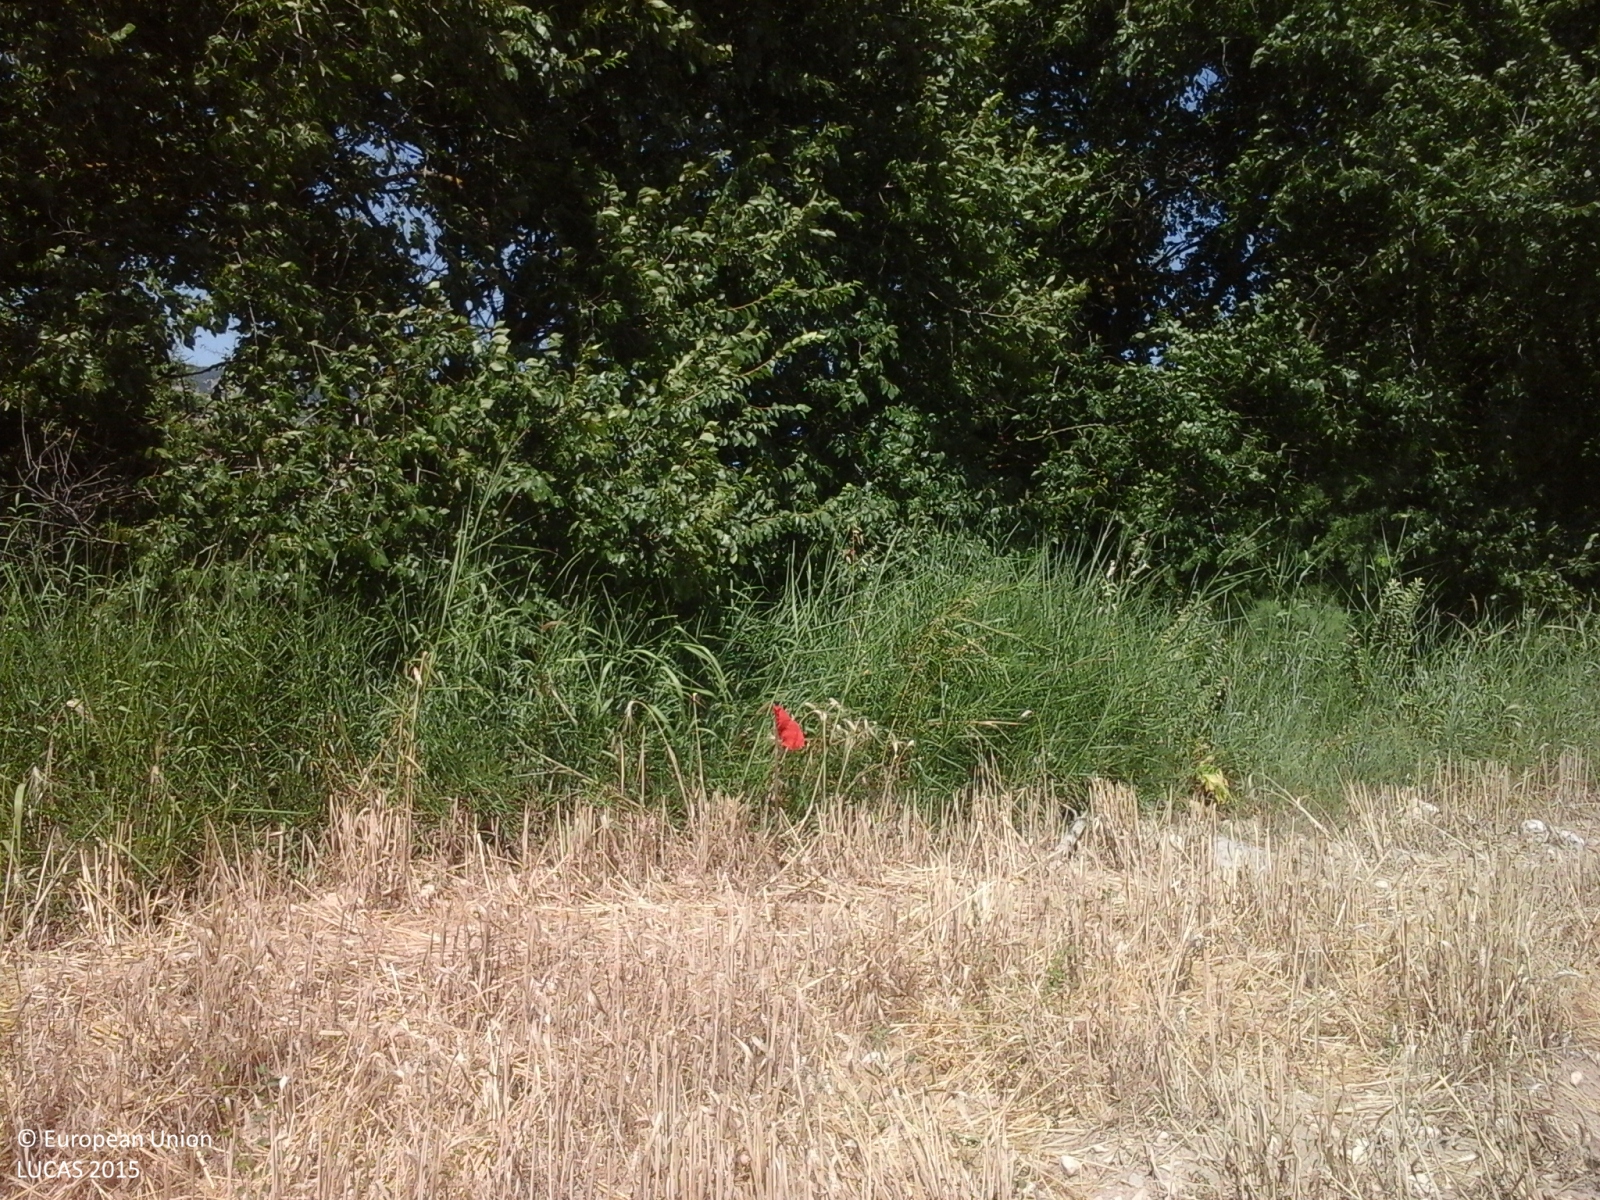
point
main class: Woodland
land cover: Other mixed woodland
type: coniferous forest of the mediterranean region
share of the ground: > 75 %
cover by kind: coniferous forest trees 35 %, broadleaved forest trees 35 %, shrubs 20 %, herbaceous plants 10 %
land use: Forestry
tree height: > 5 m
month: June
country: IT
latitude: 37.6420
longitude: 13.1158
